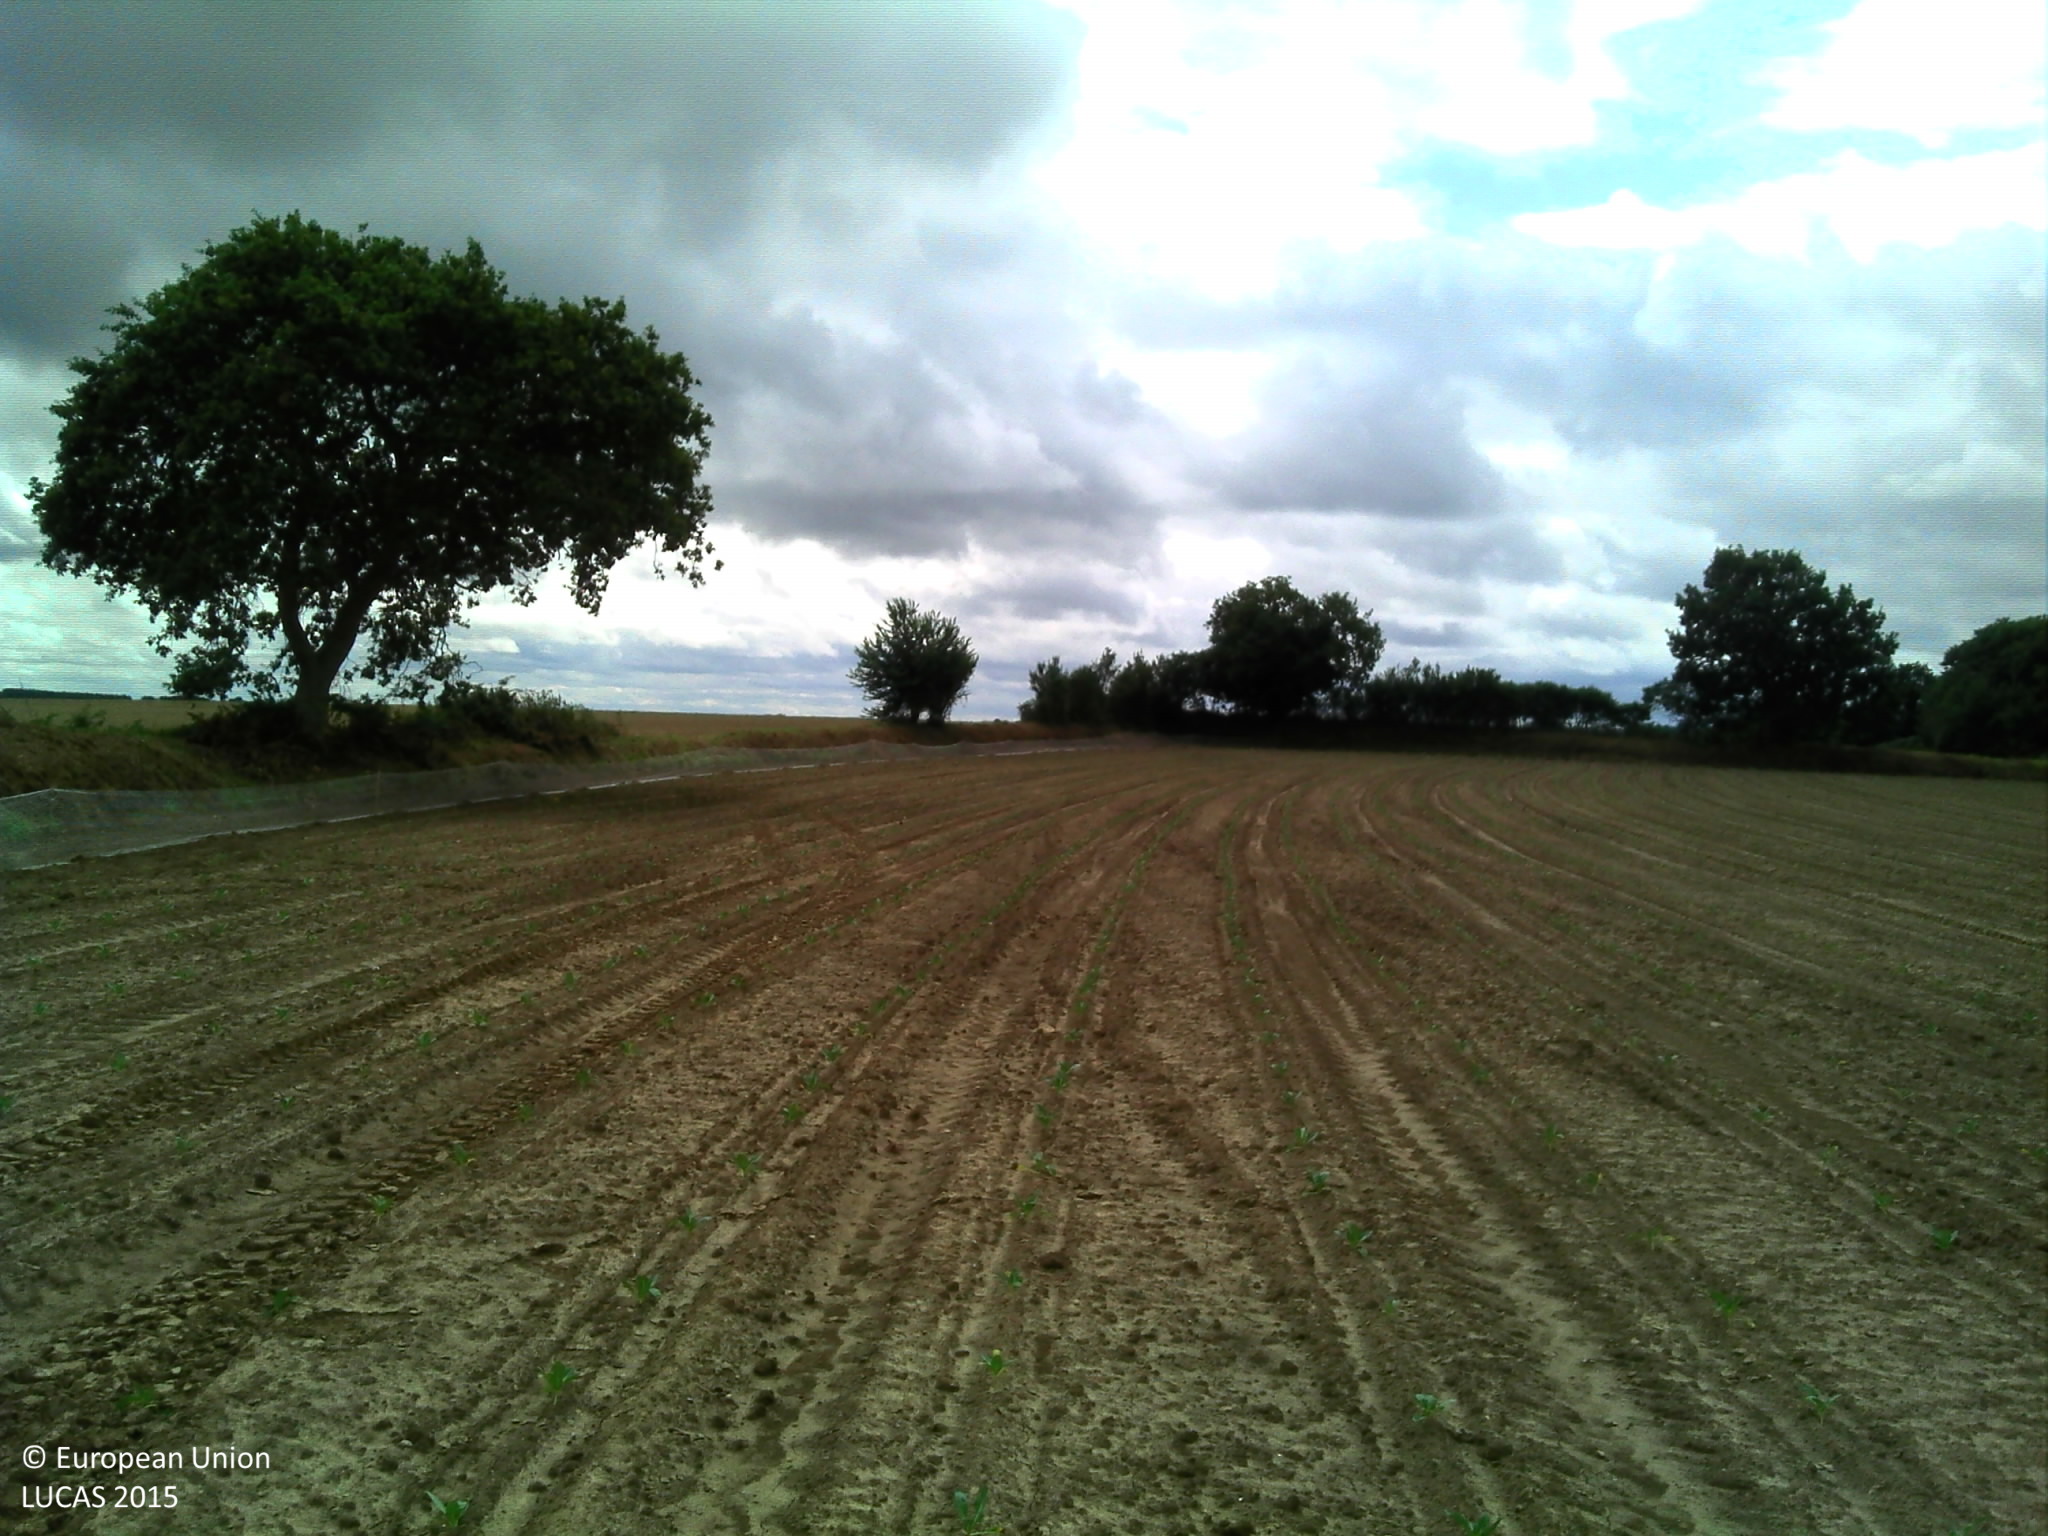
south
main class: Cropland
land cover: Other fresh vegetables
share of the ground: < 10 %
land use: Agriculture (excluding fallow land and kitchen gardens)
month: August
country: FR
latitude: 48.7739
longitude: -3.2056
